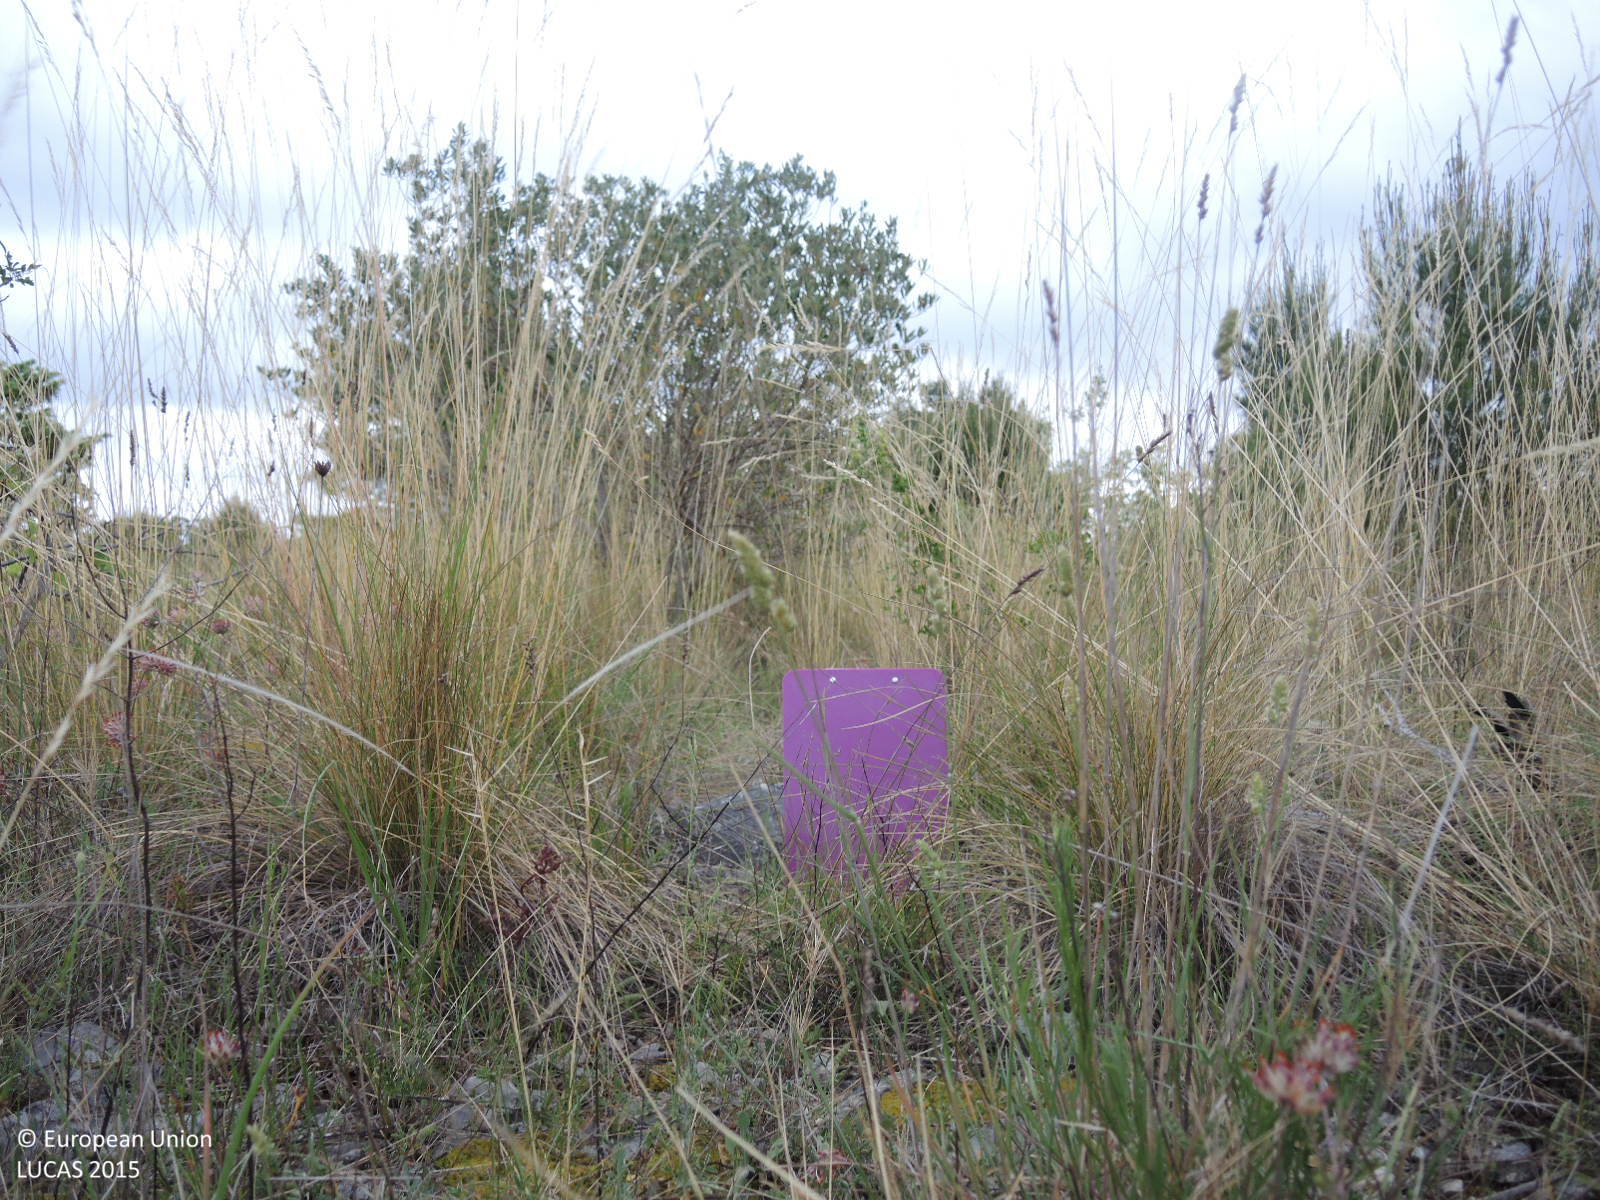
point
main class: Cropland
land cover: Olive groves
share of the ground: 10 - 25 %
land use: Agriculture (excluding fallow land and kitchen gardens)
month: May
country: HR
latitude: 43.7535
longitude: 15.8158
